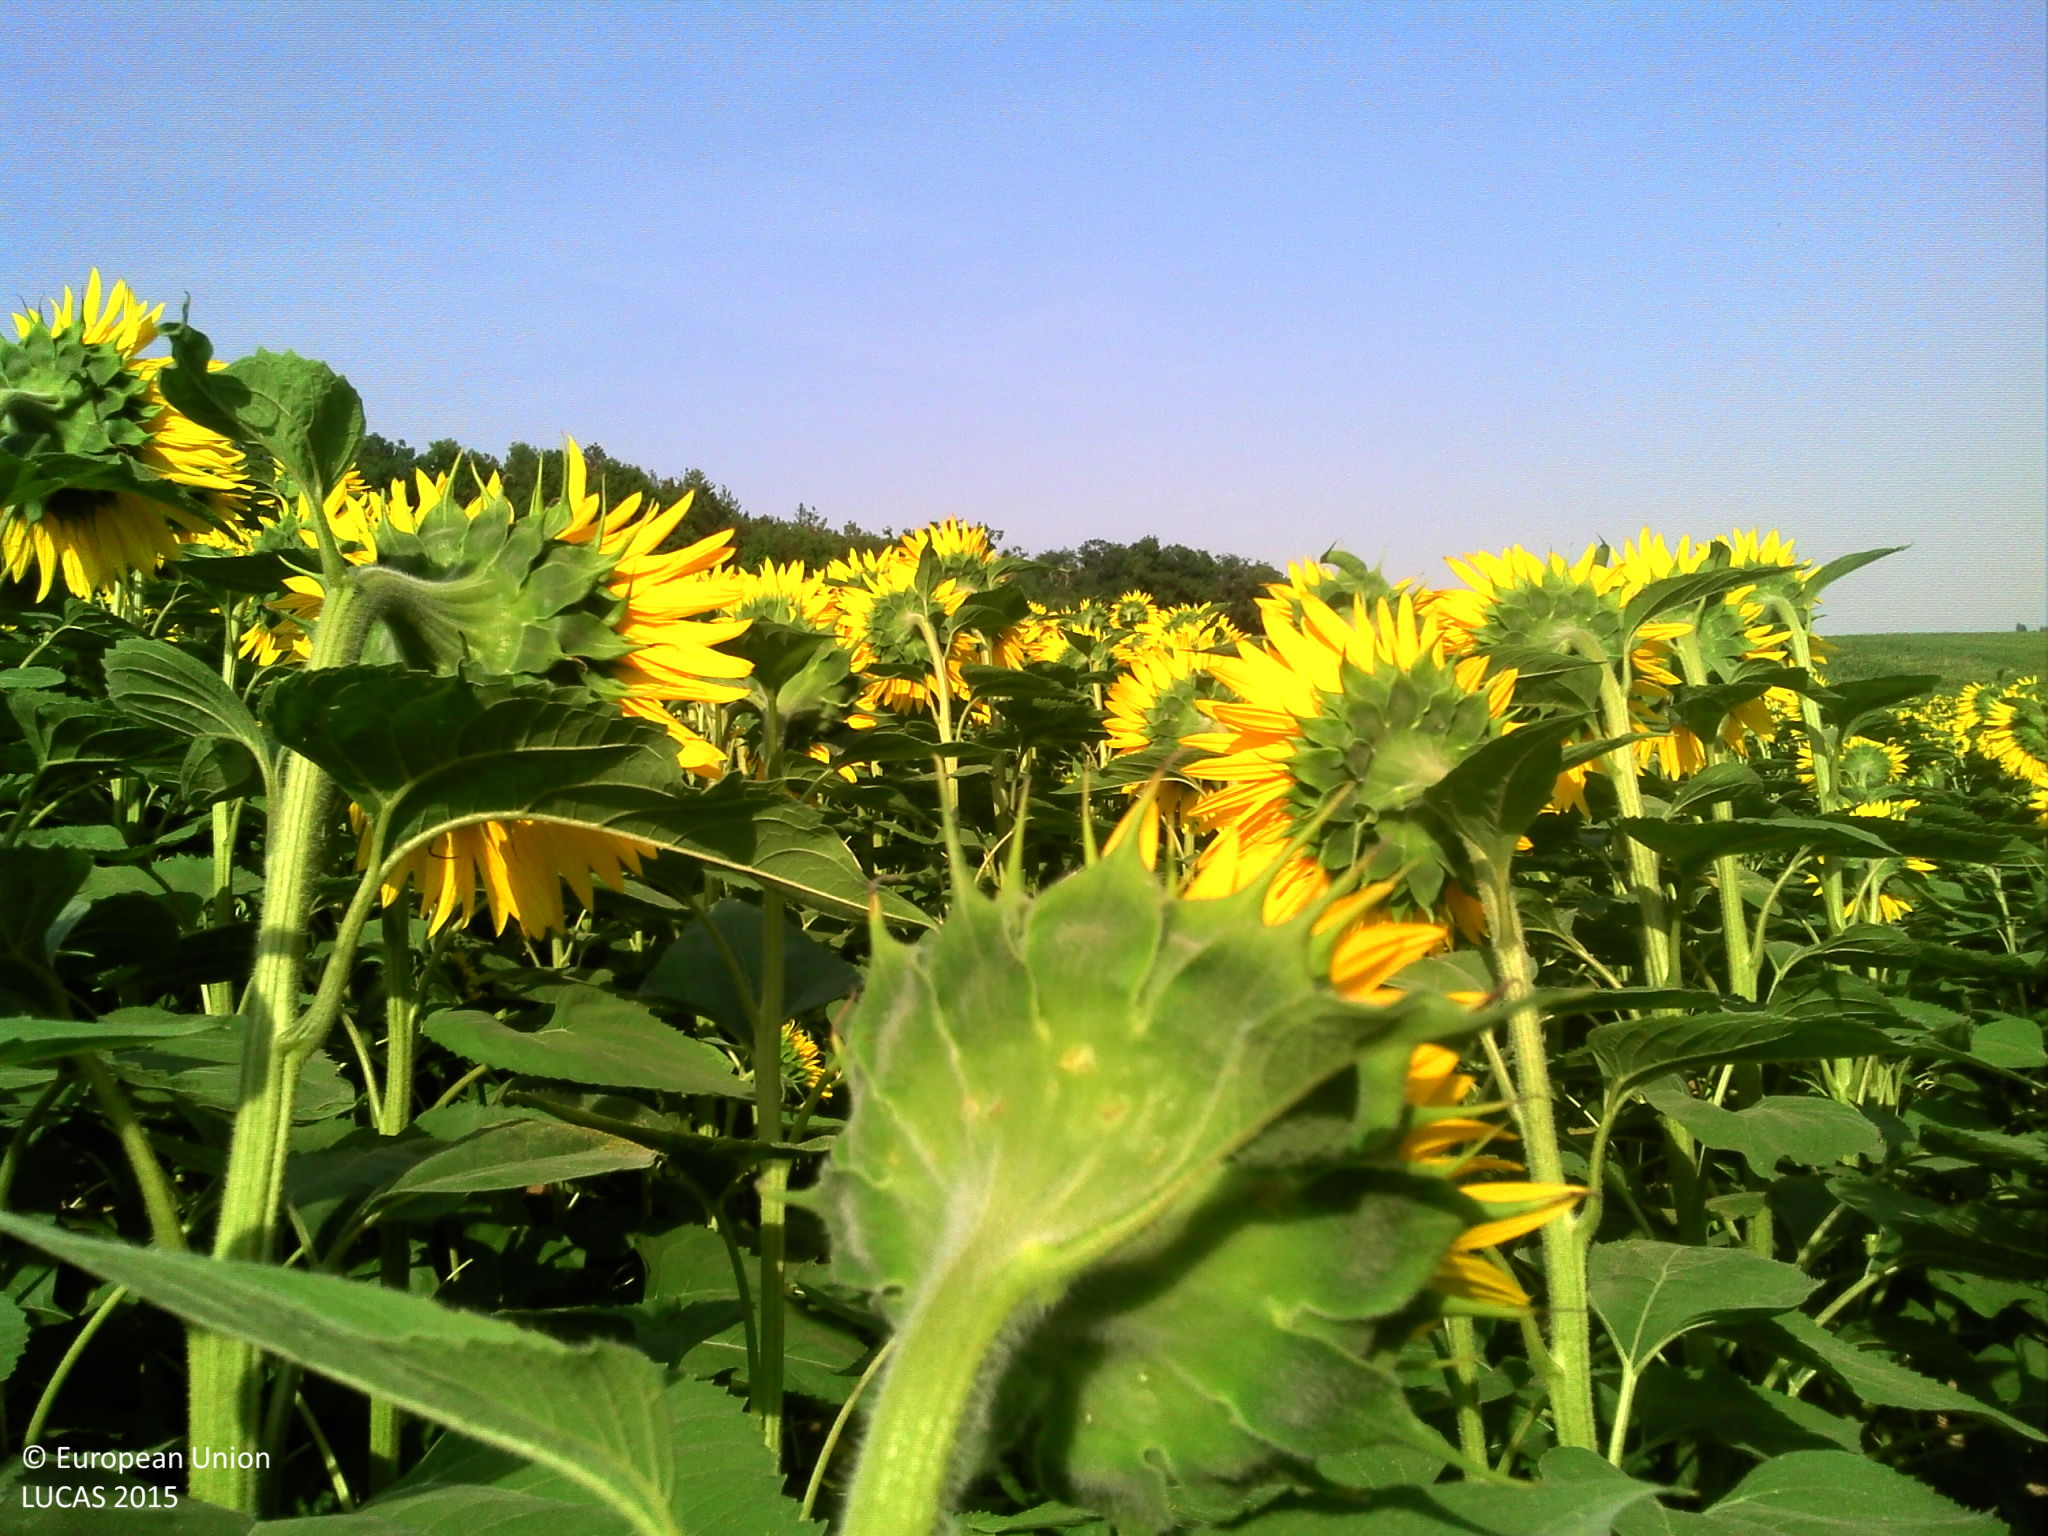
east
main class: Cropland
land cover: Sunflower
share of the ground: > 75 %
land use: Agriculture (excluding fallow land and kitchen gardens)
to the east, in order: Sunflower; Broadleaved woodland; Spontaneously vegetated surfaces; Rivers and streams; Broadleaved woodland
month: July
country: FR
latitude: 43.6457
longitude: 1.5852
